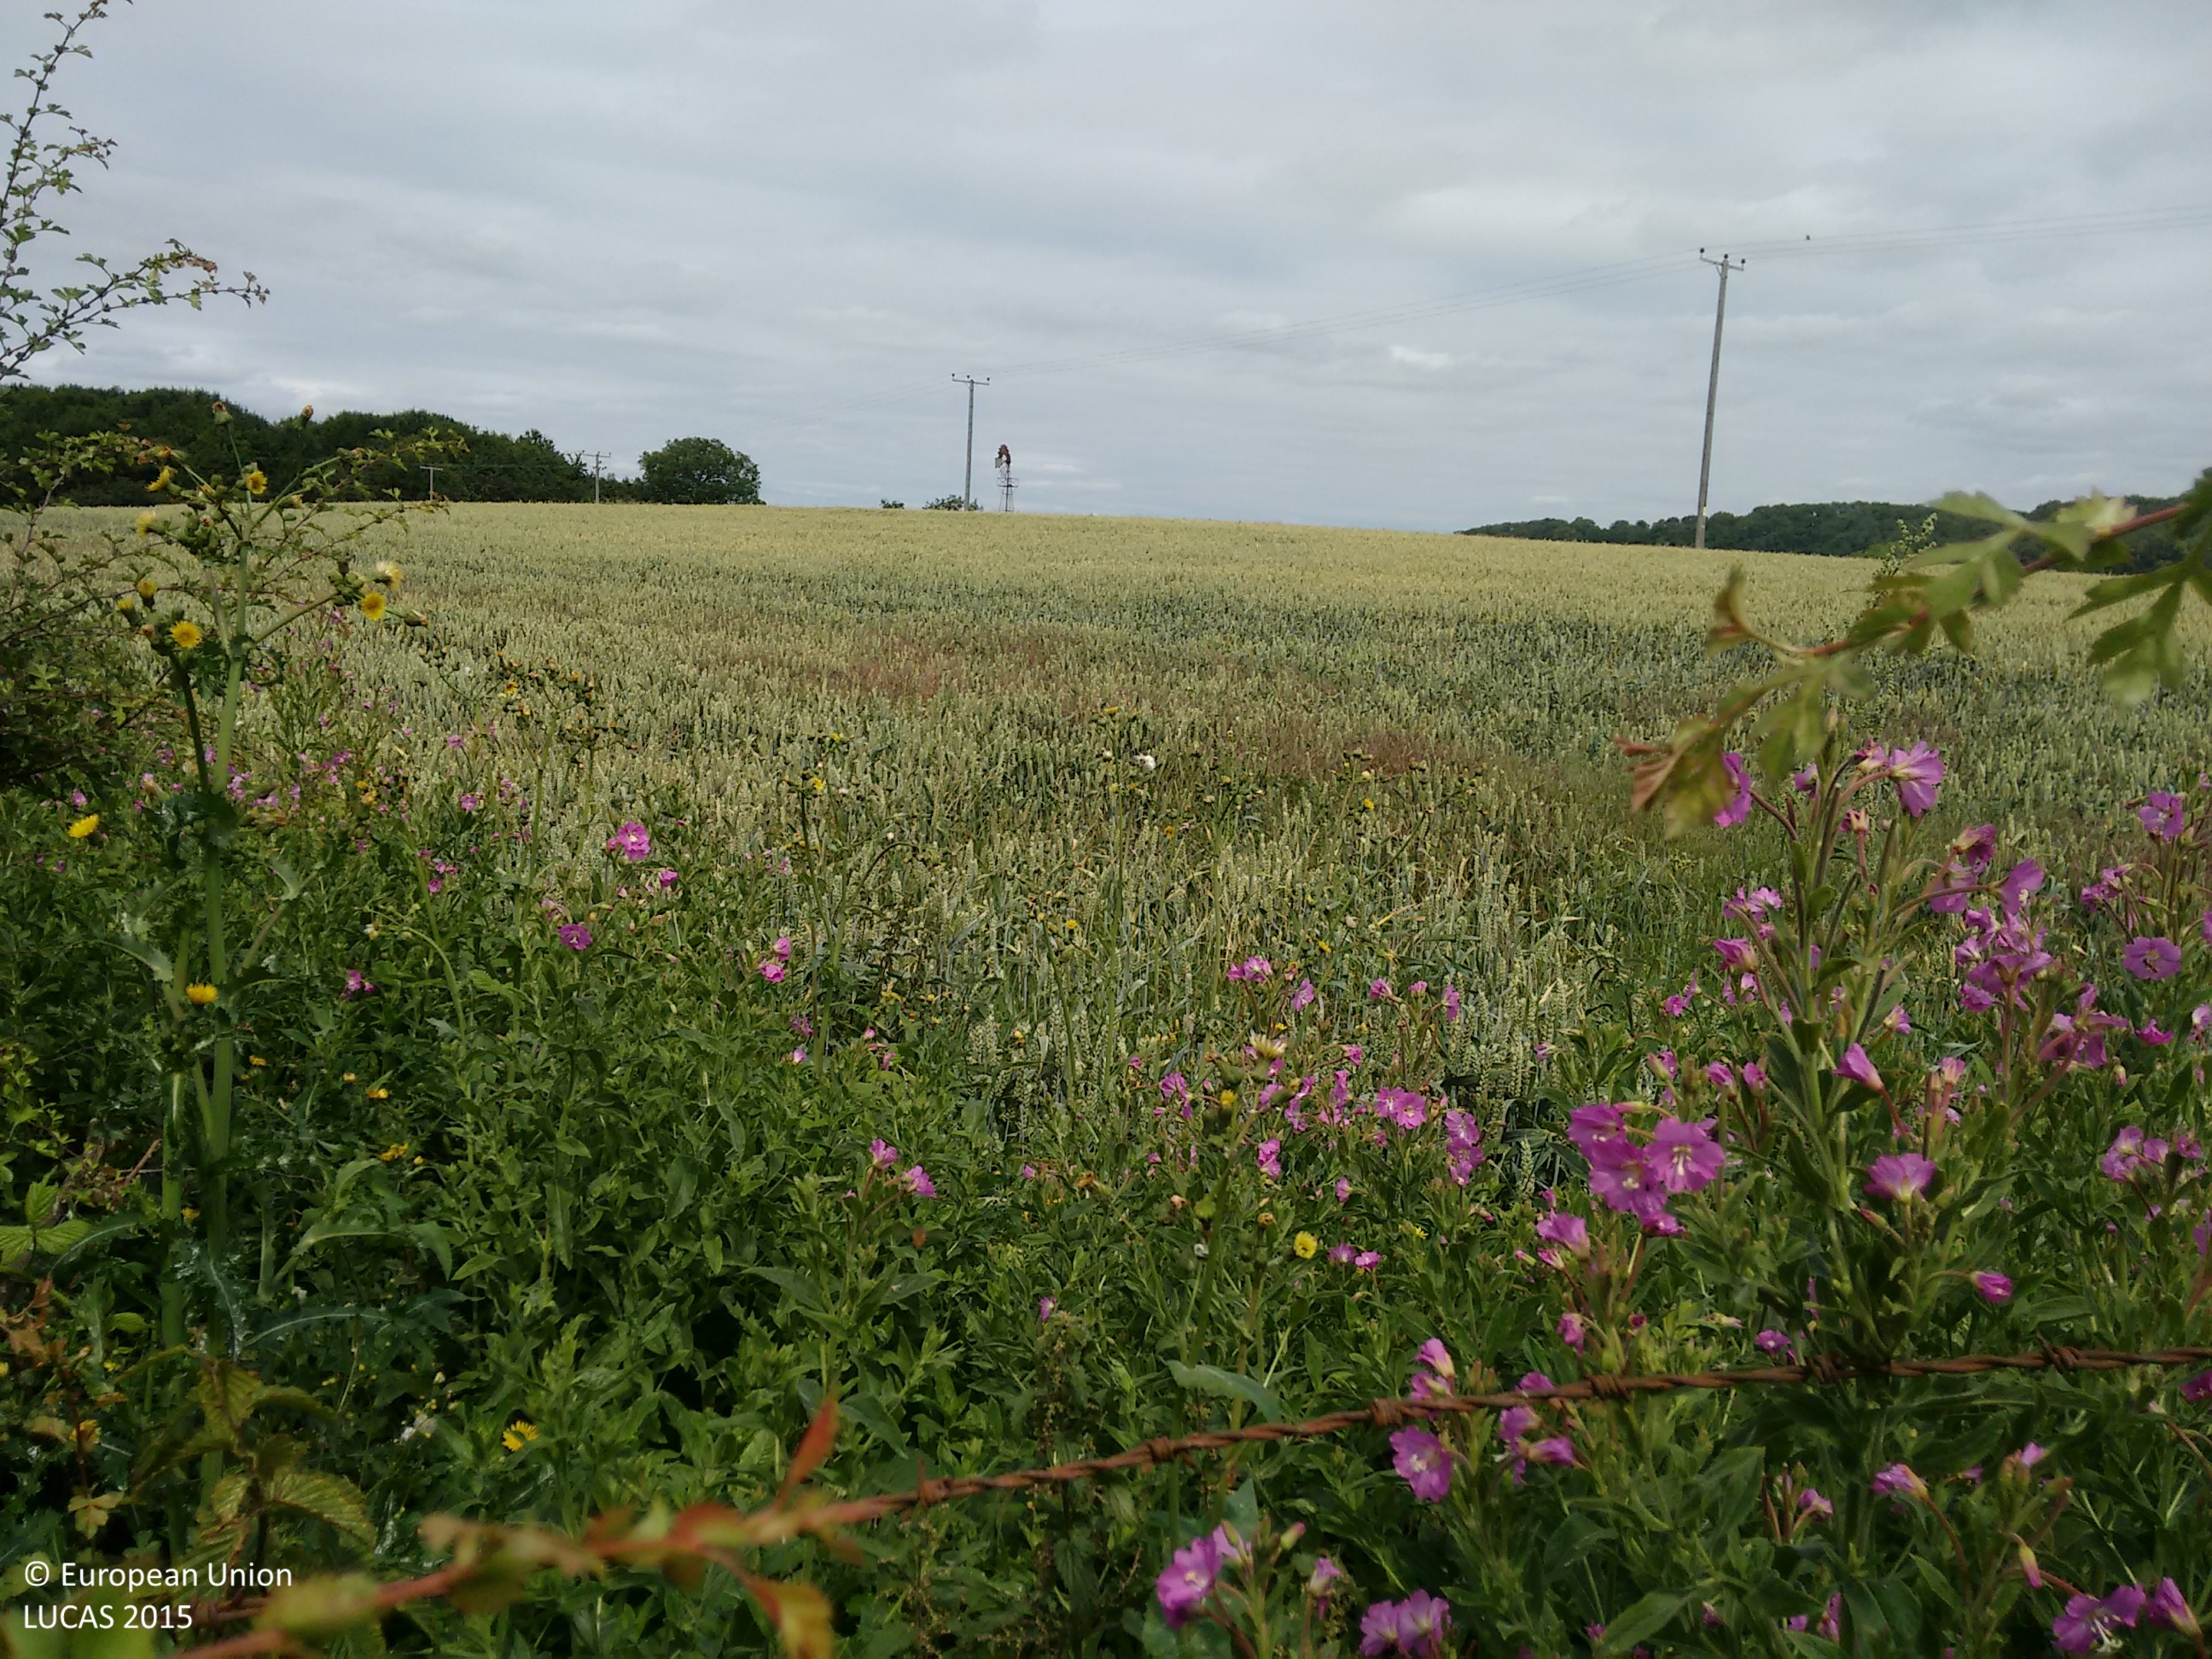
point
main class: Cropland
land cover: Common wheat
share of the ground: > 75 %
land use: Agriculture (excluding fallow land and kitchen gardens)
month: July
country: GB
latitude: 52.1292
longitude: -2.5275
